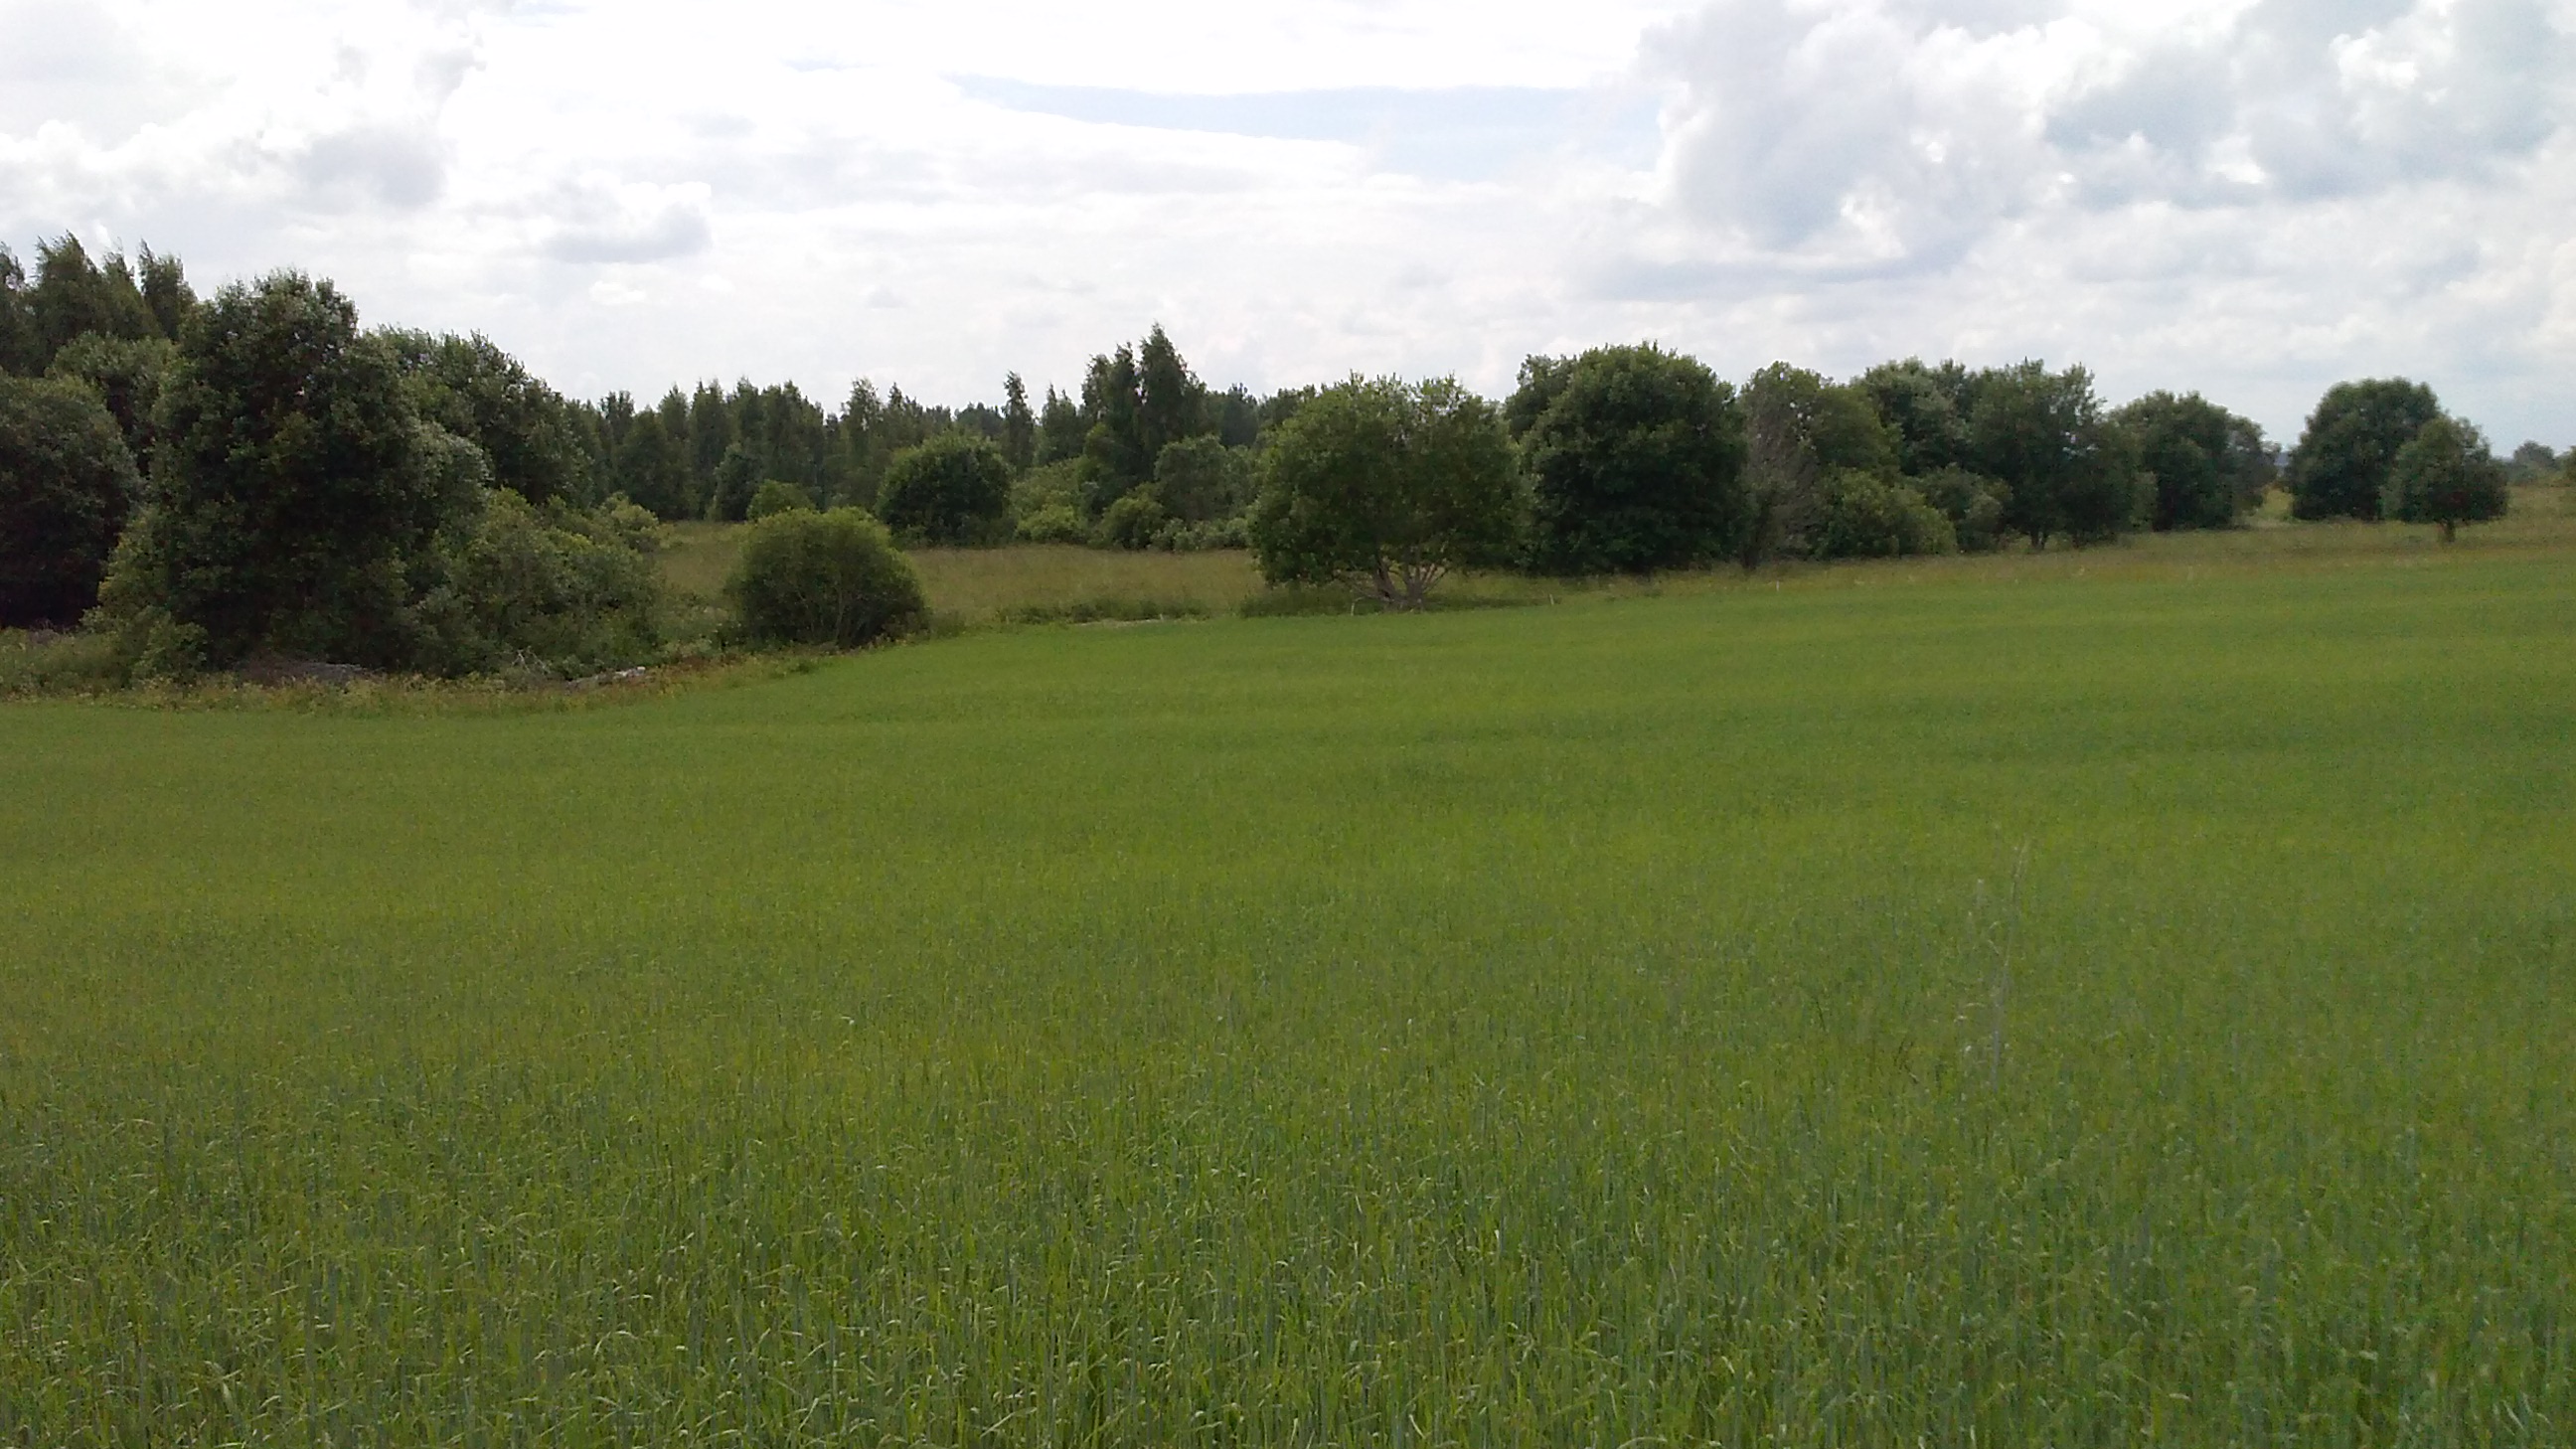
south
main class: Cropland
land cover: Oats
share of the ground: > 75 %
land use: Agriculture (excluding fallow land and kitchen gardens)
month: June
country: LV
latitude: 56.5567
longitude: 27.7758
